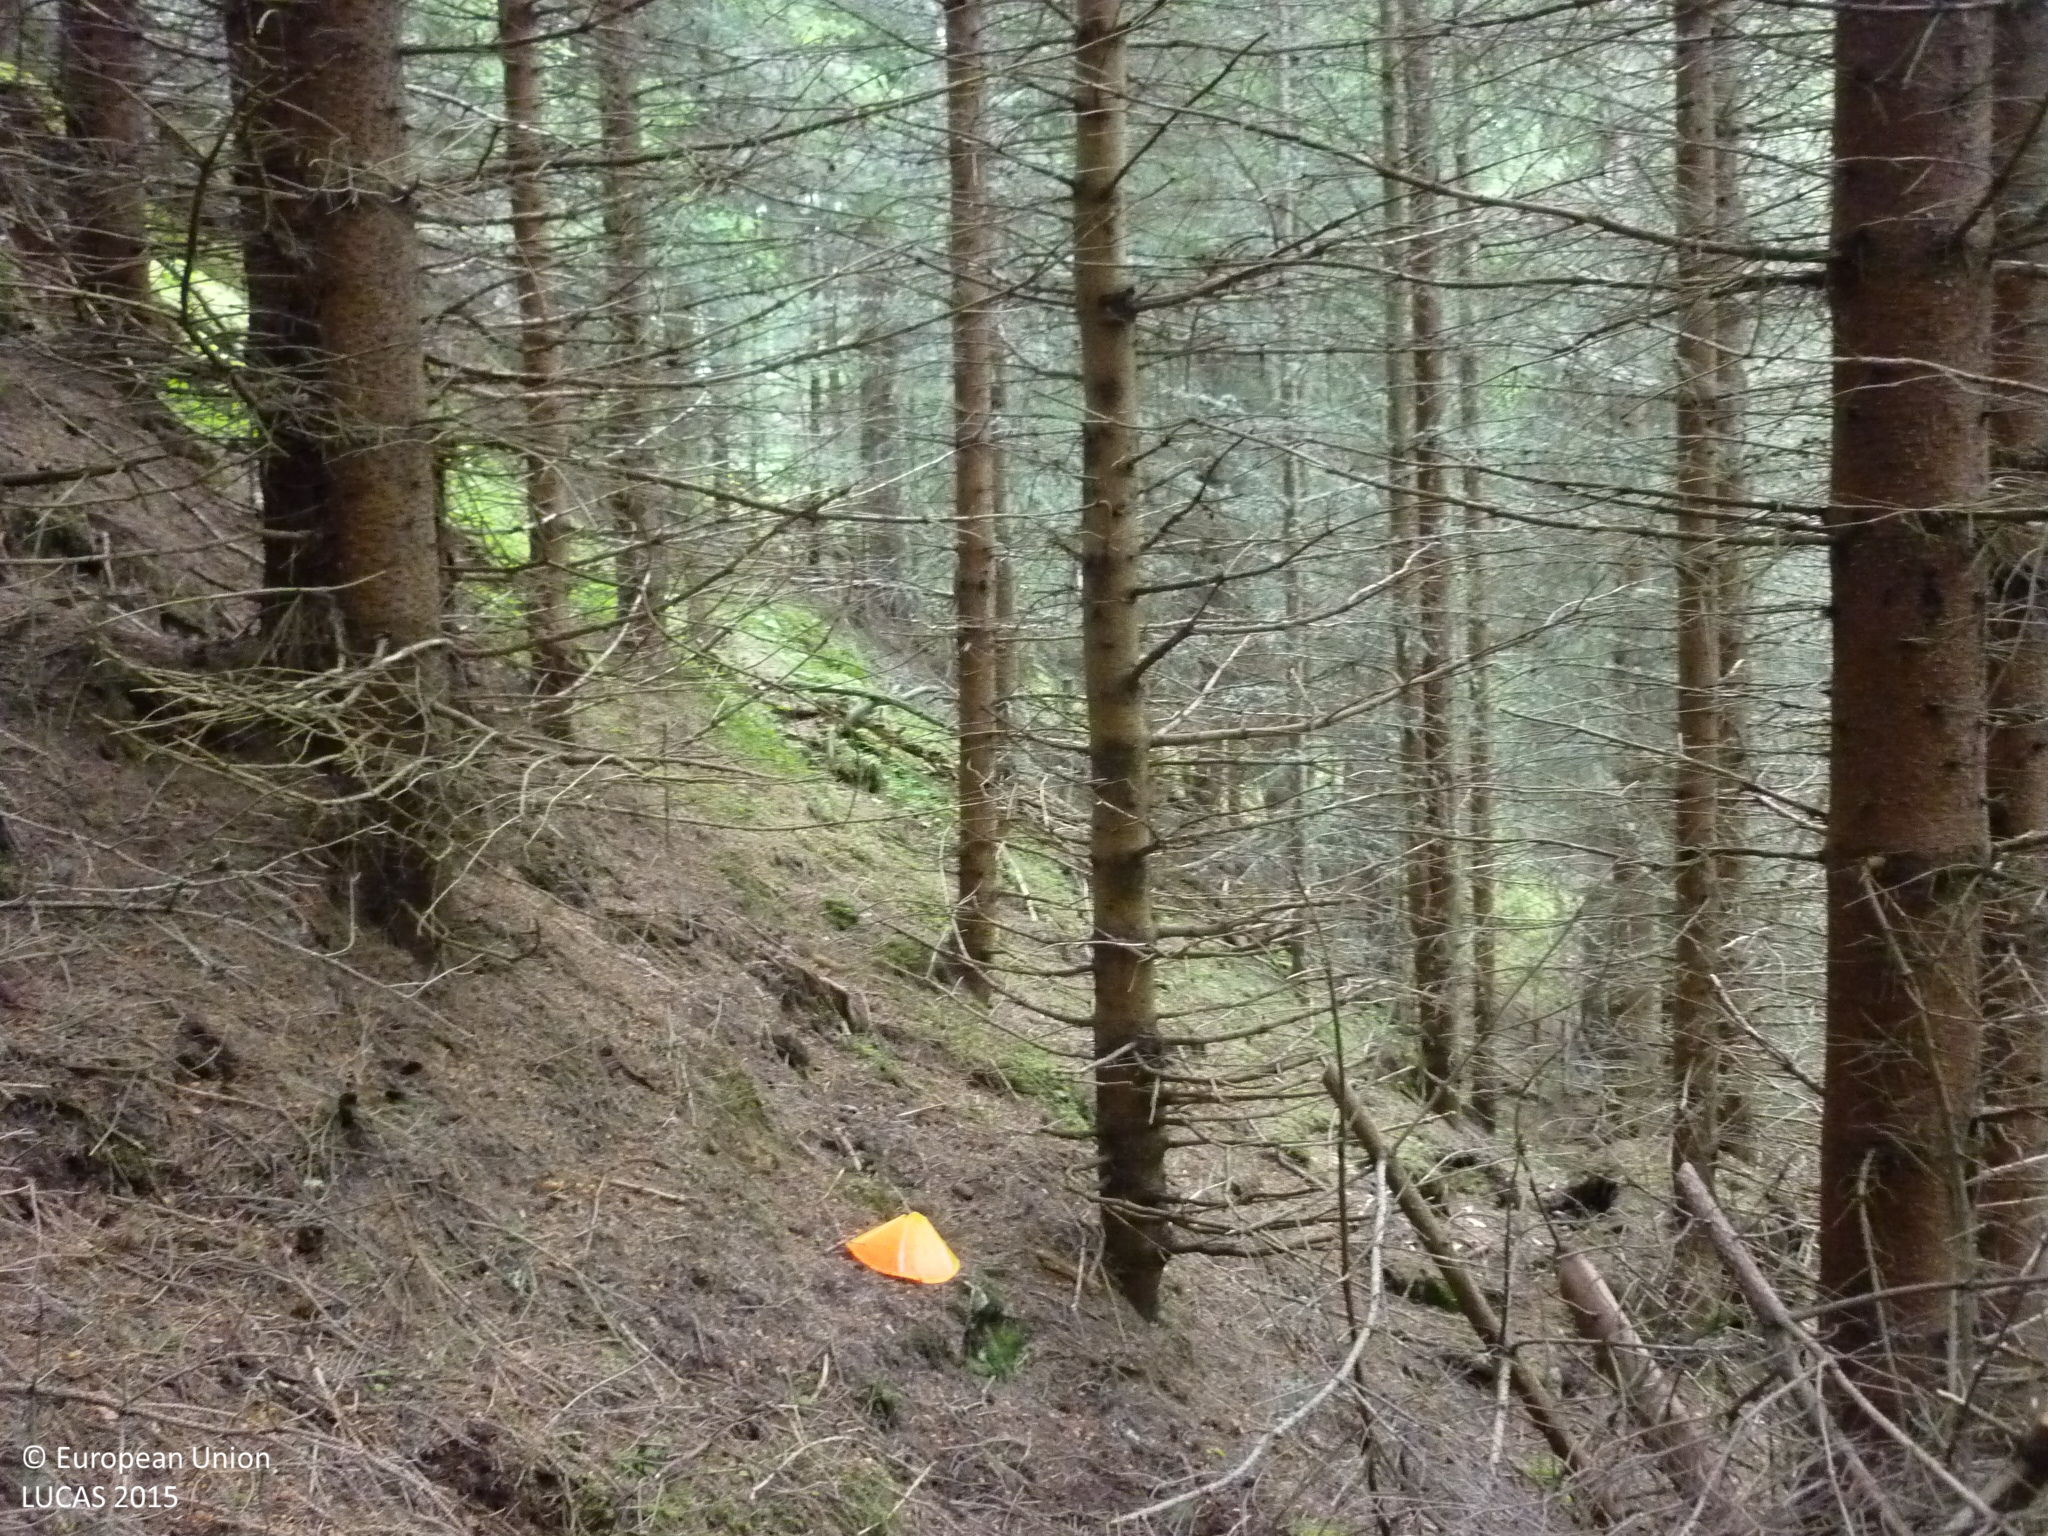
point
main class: Woodland
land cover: Spruce dominated coniferous woodland
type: alpine coniferous forest
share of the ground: > 75 %
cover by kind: coniferous forest trees 100 %
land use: Forestry
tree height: > 5 m
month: June
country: AT
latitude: 47.1721
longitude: 14.1542
